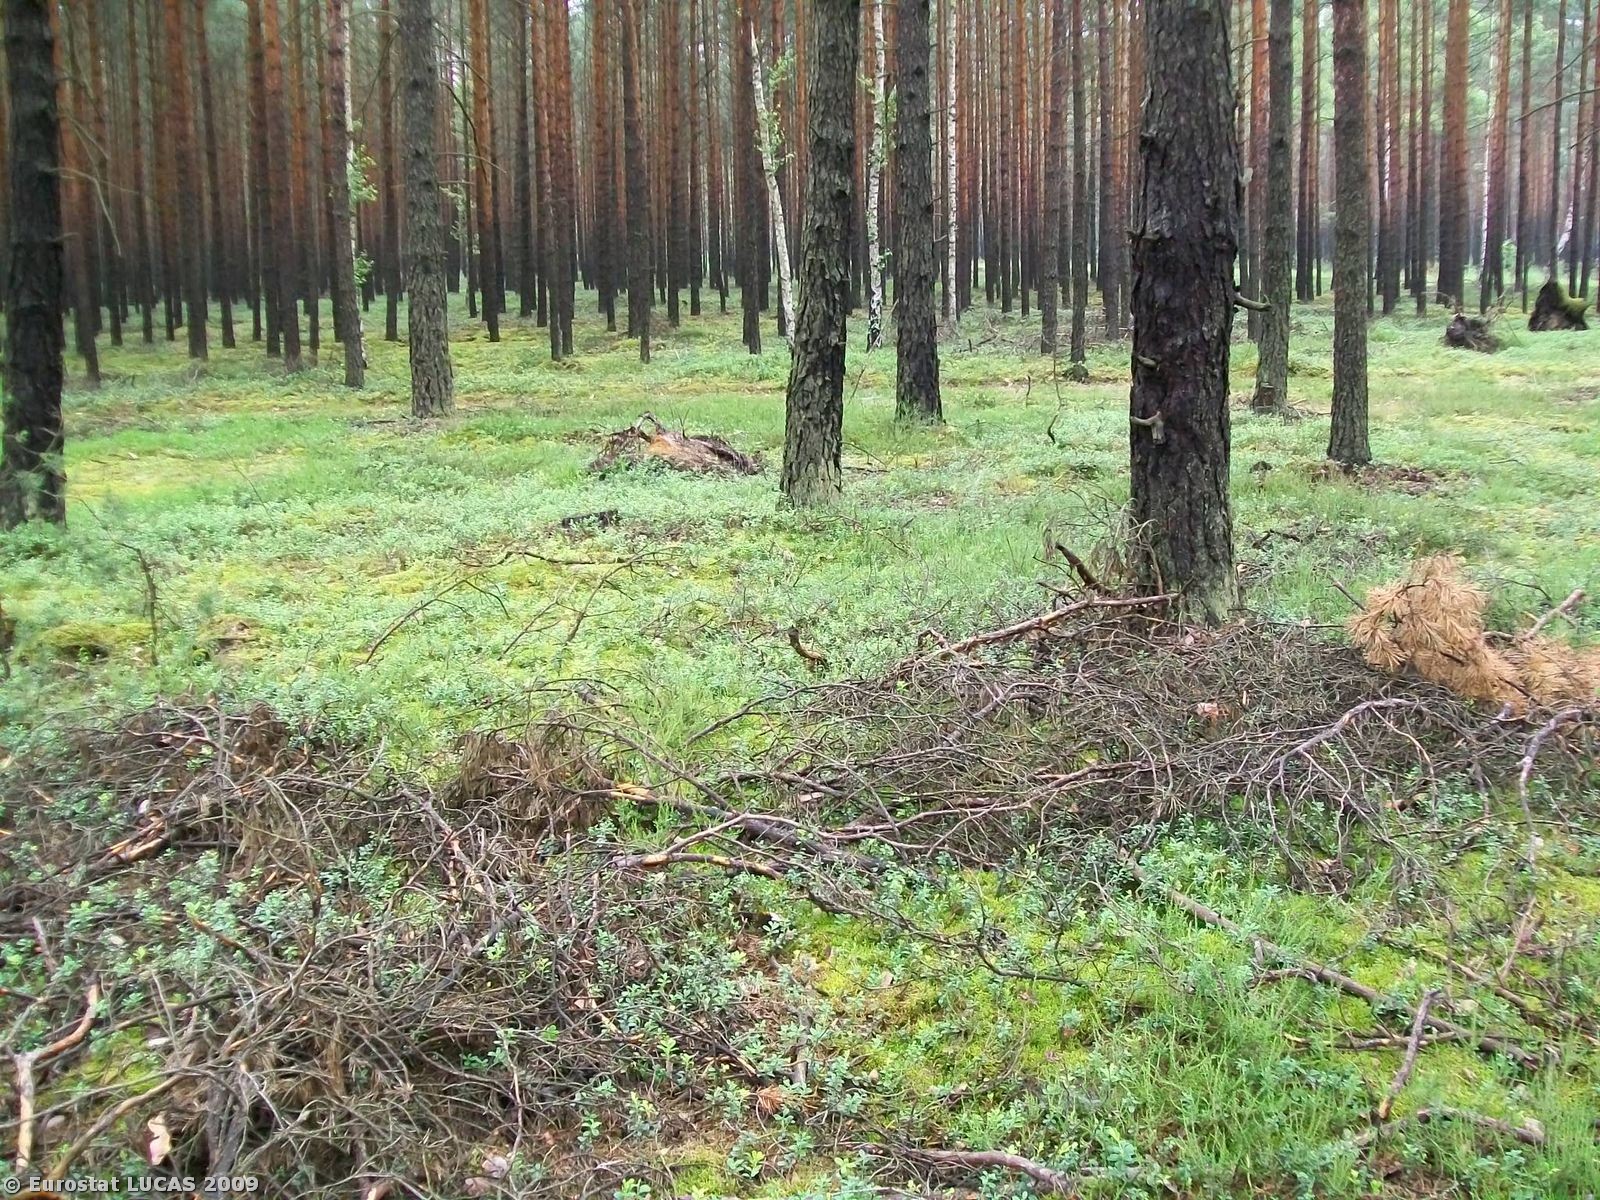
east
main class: Woodland
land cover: Coniferous woodland
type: hemiboreal forest and nemoral coniferous forest and mixed broadleaved-coniferous forest
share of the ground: > 75 %
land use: Forestry
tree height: > 5 m
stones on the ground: < 10 %
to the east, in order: Coniferous woodland; Paved roads, cycling and walking lanes; Coniferous woodland
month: June
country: PL
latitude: 51.4172
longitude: 15.1943
